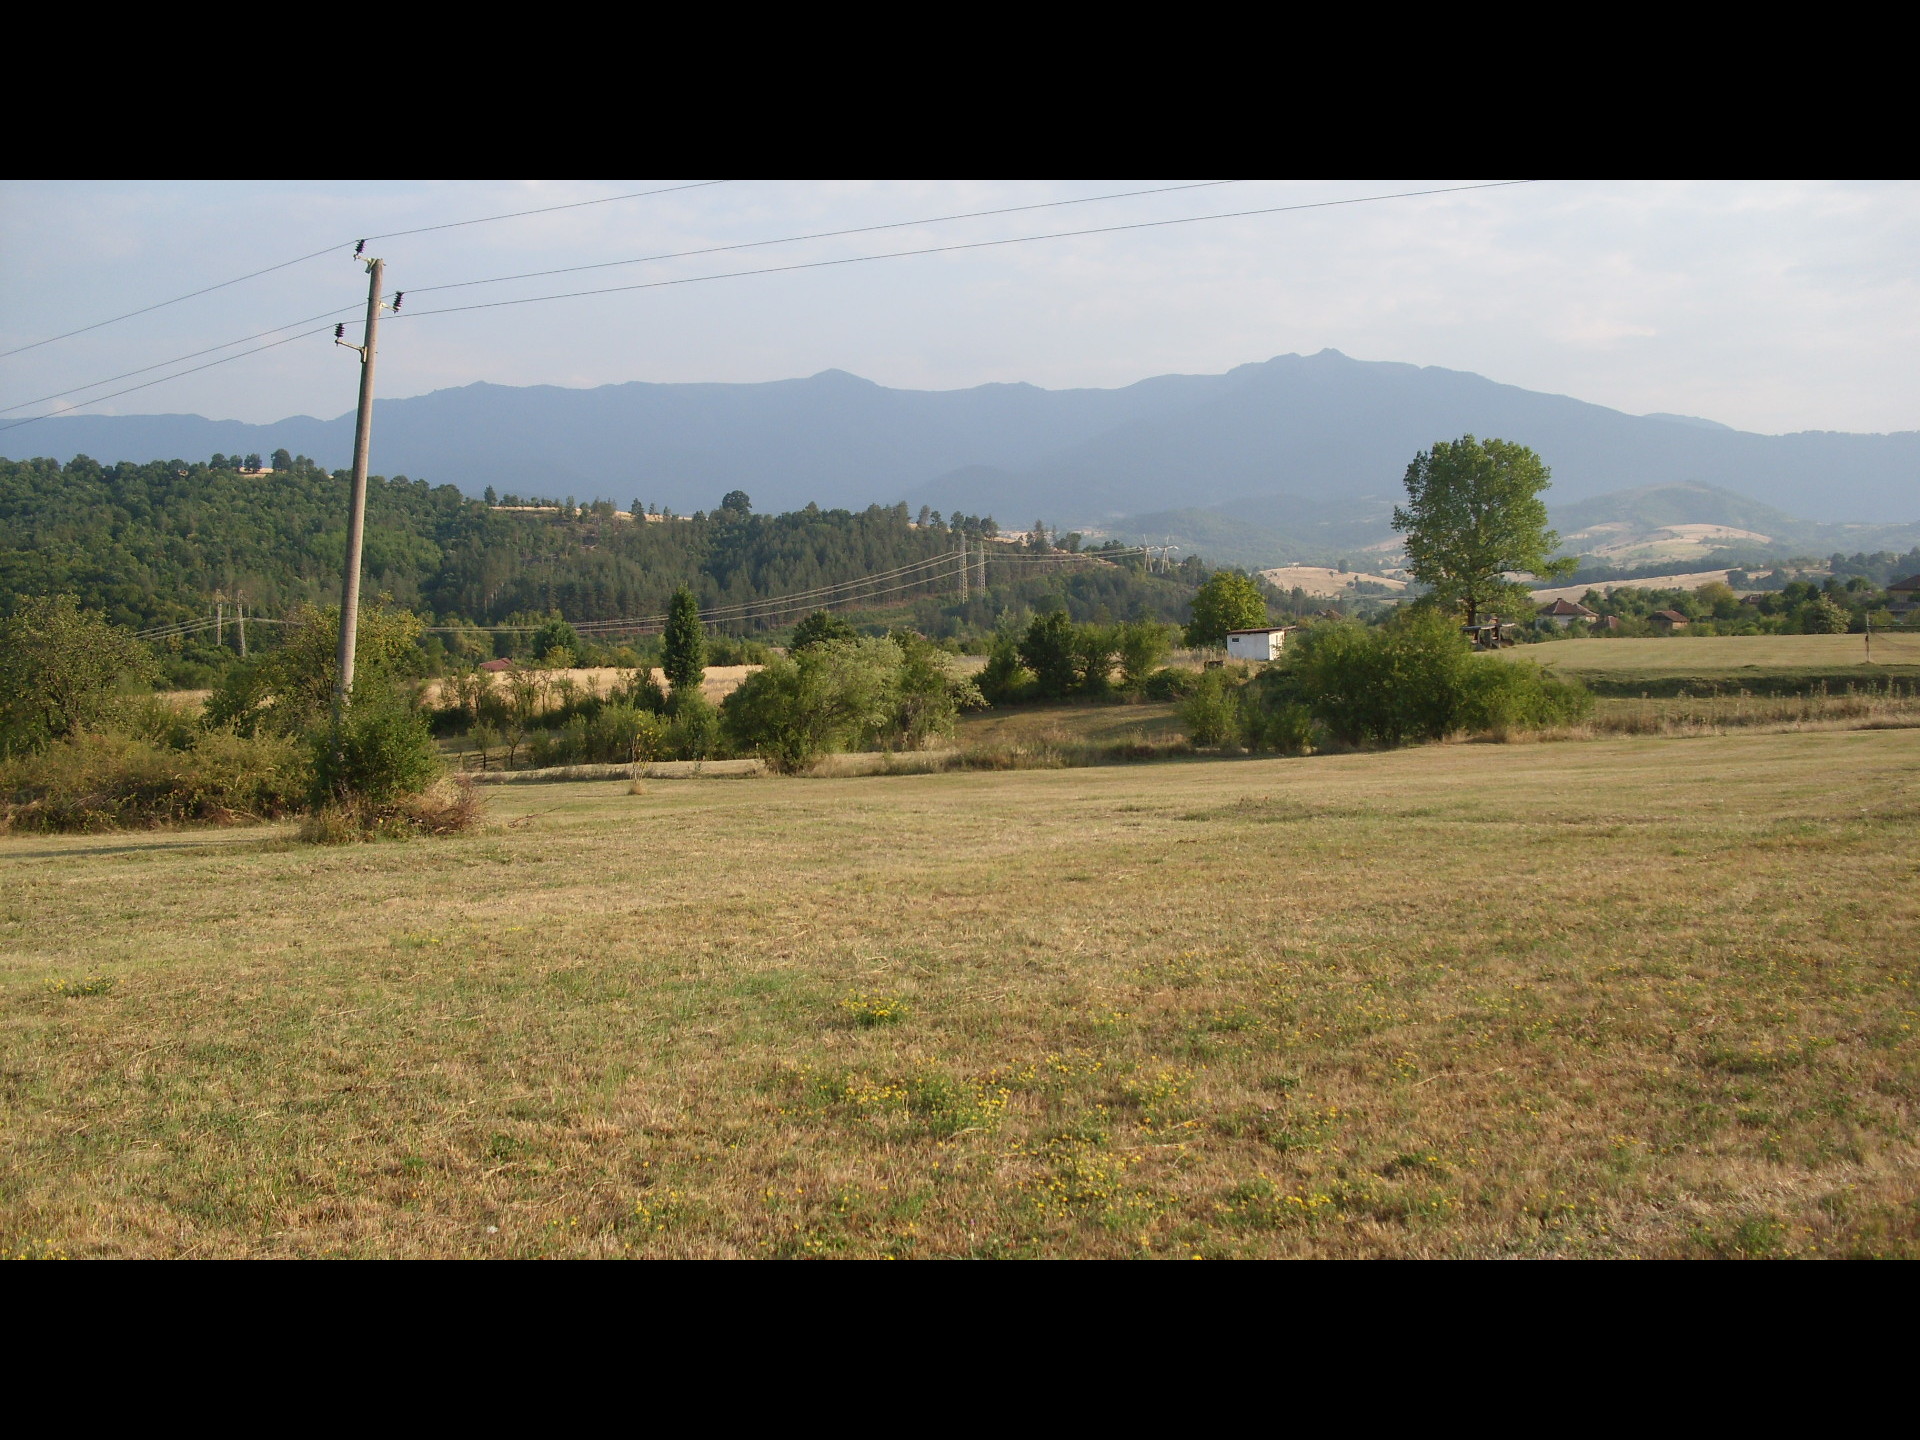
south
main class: Grassland
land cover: Grassland without tree/shrub cover
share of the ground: > 75 %
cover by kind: herbaceous plants 100 %
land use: Agriculture (excluding fallow land and kitchen gardens)
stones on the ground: < 10 %
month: August
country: BG
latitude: 43.2406
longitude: 23.2524
